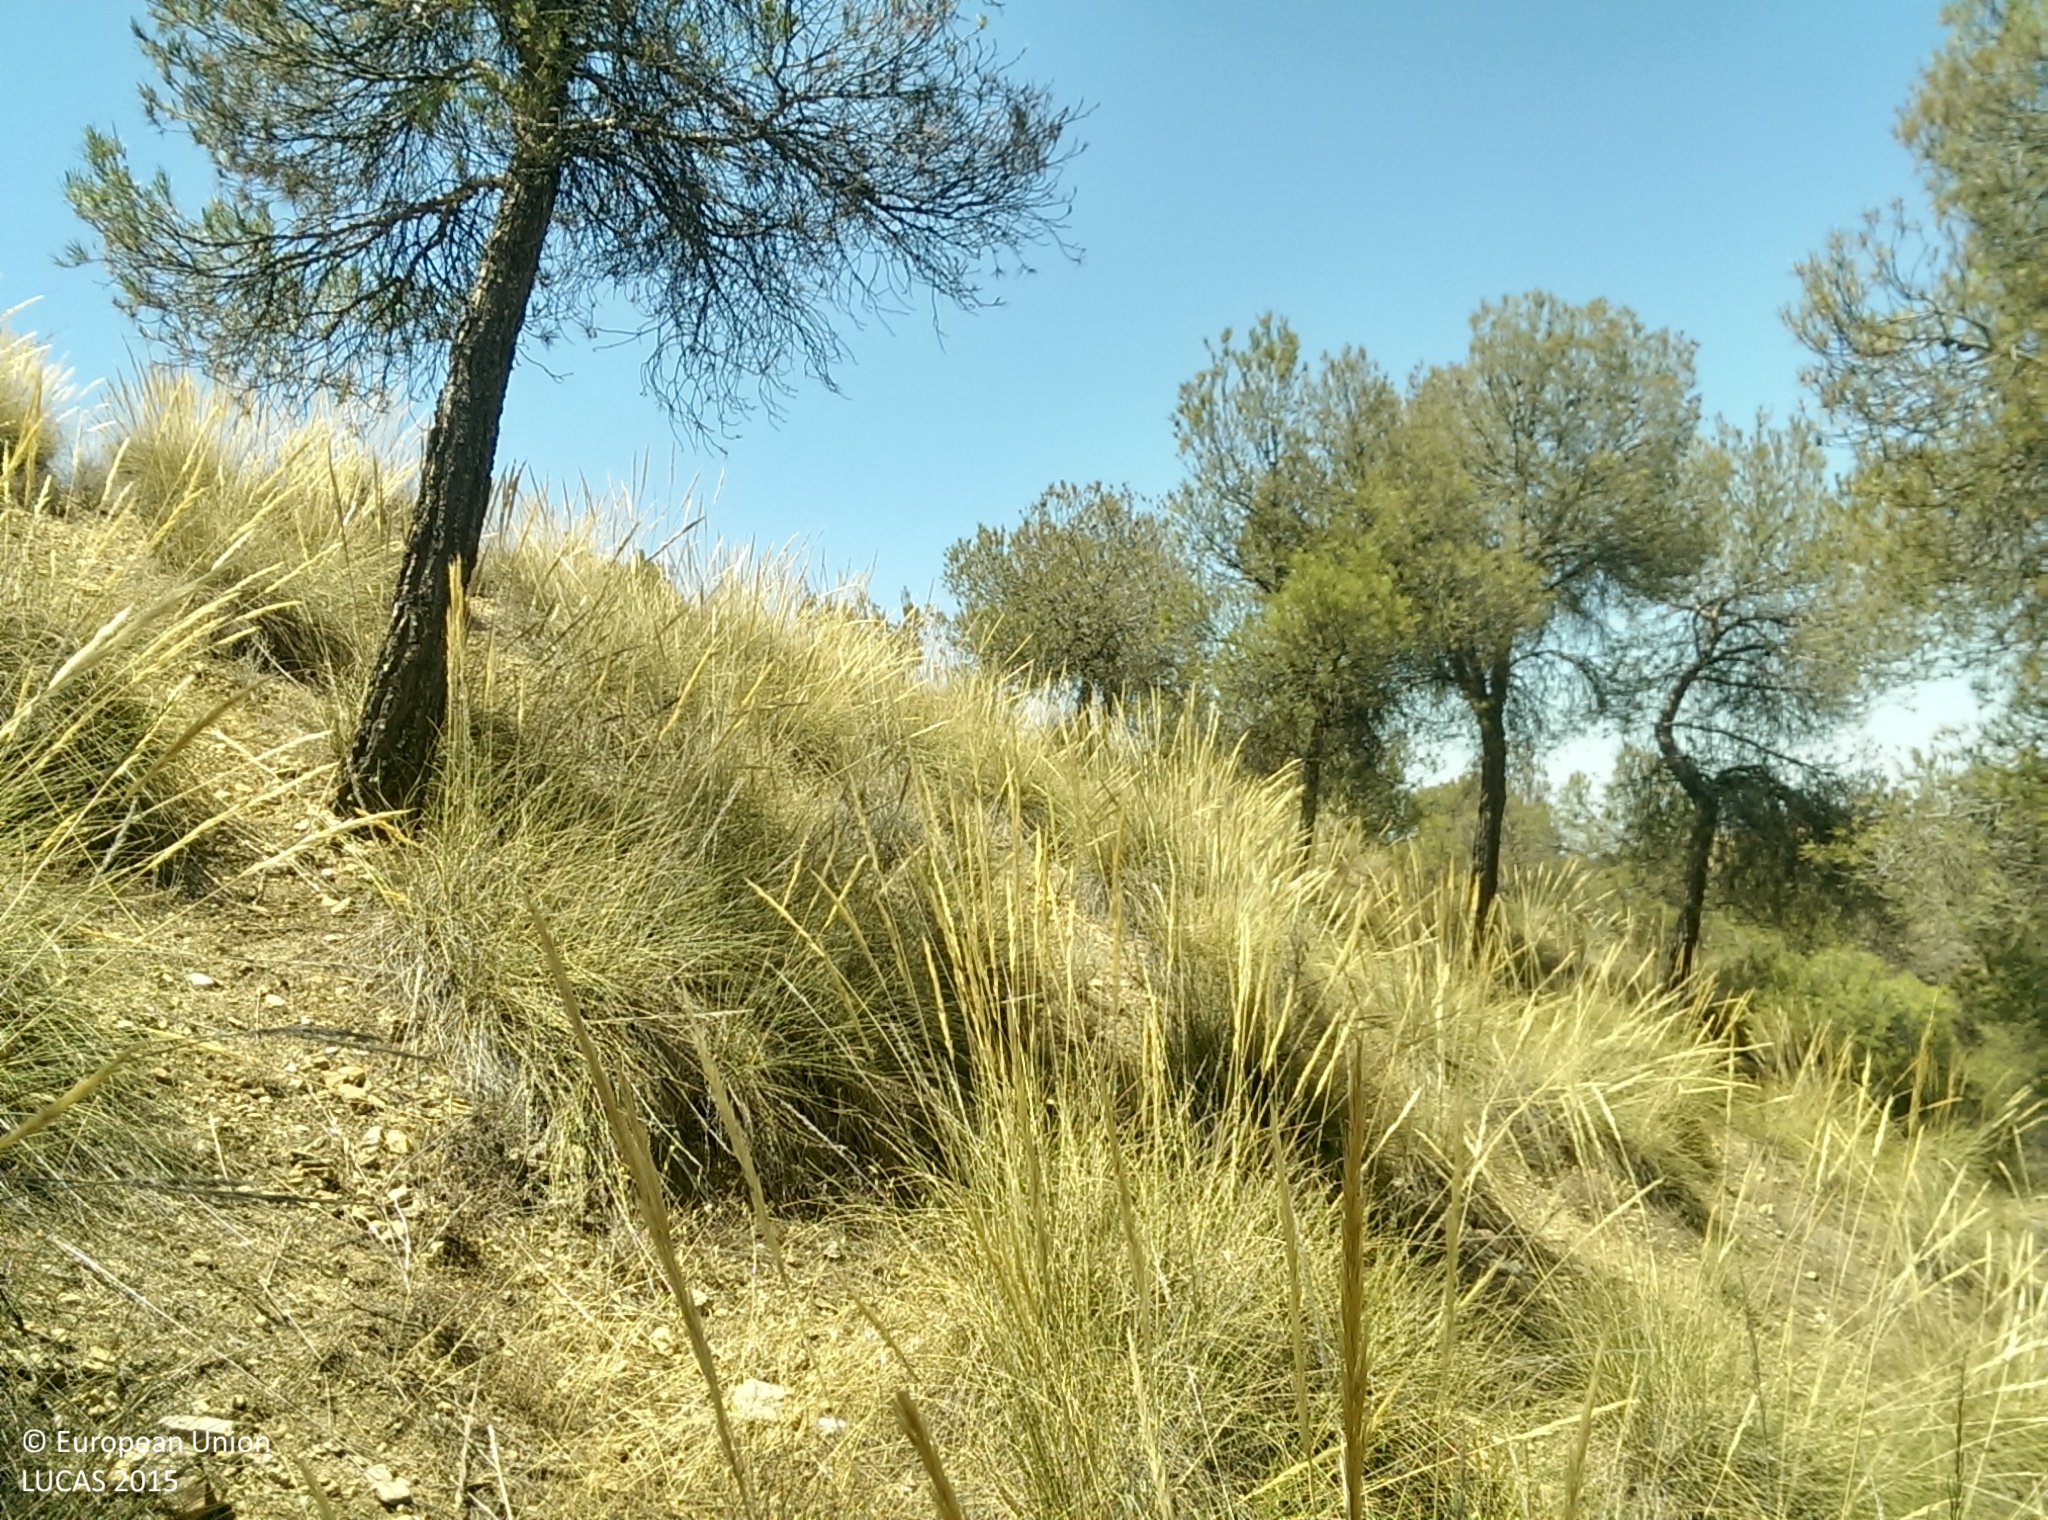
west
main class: Woodland
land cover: Pine dominated coniferous woodland
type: coniferous forest of the mediterranean region
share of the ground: 50 - 75 %
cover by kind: coniferous forest trees 60 %, herbaceous plants 25 %, shrubs 10 %, unconsolidated bare surface 5 %
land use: Forestry
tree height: > 5 m
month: July
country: ES
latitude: 37.3128
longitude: -3.1096
